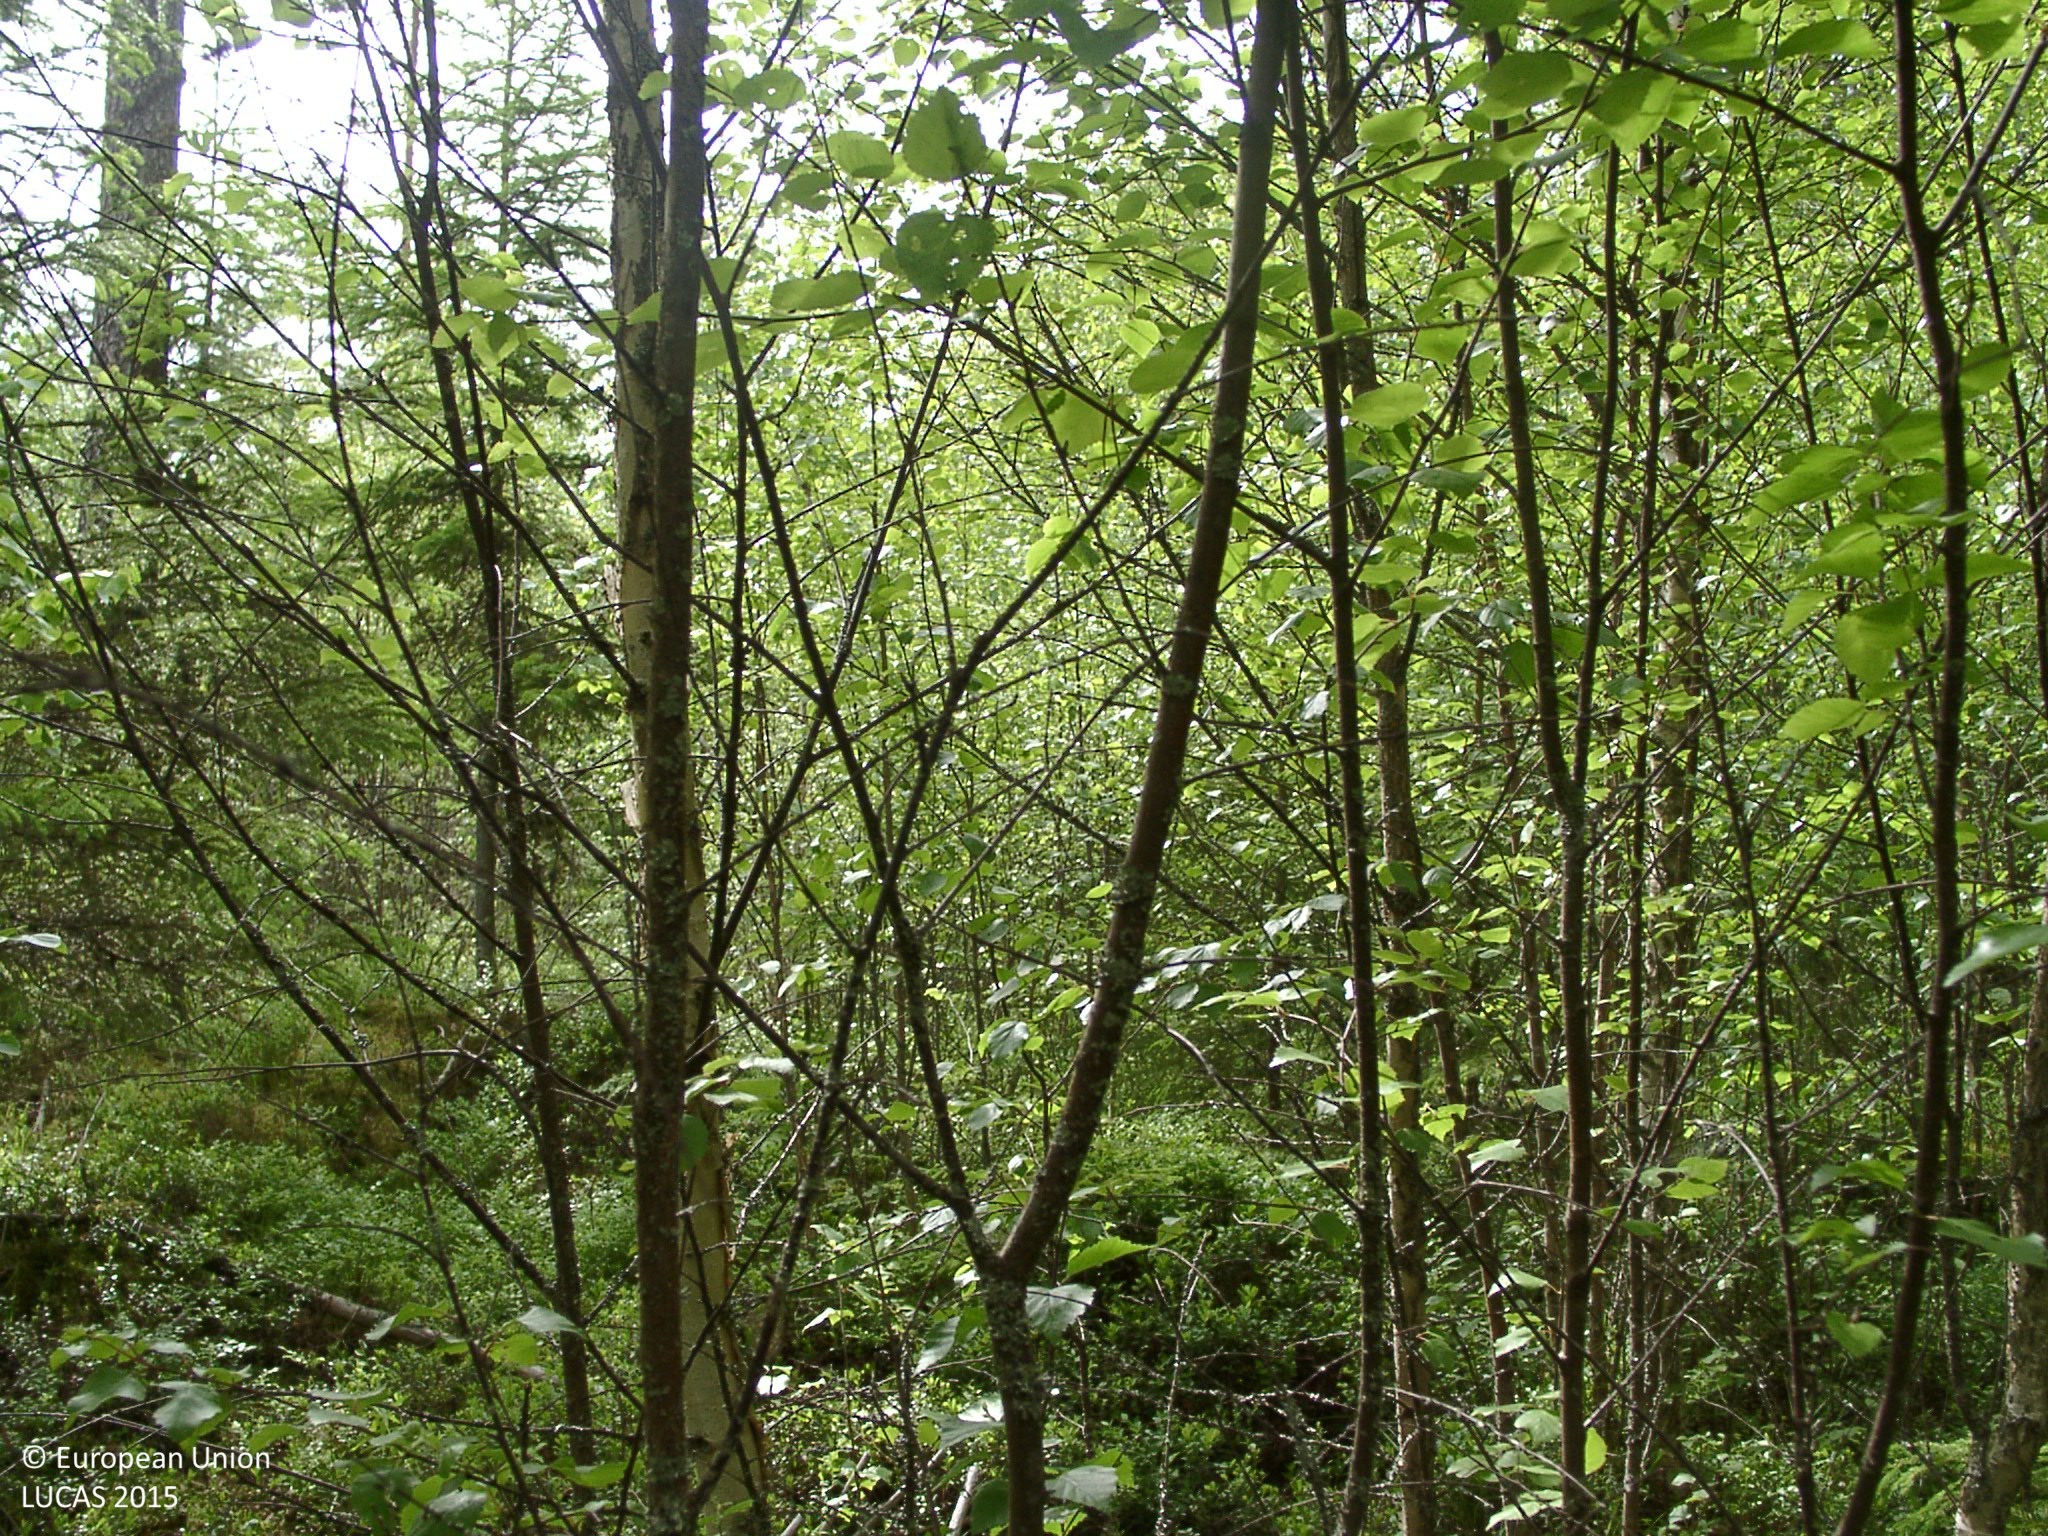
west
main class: Woodland
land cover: Broadleaved woodland
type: non-riverine alder, birch or aspen forest
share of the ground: 50 - 75 %
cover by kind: broadleaved forest trees 60 %, shrubs 30 %, coniferous forest trees 5 %, lichens and mosses 5 %
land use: Forestry
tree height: < 5 m
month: June
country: FI
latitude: 61.8925
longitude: 24.8095
